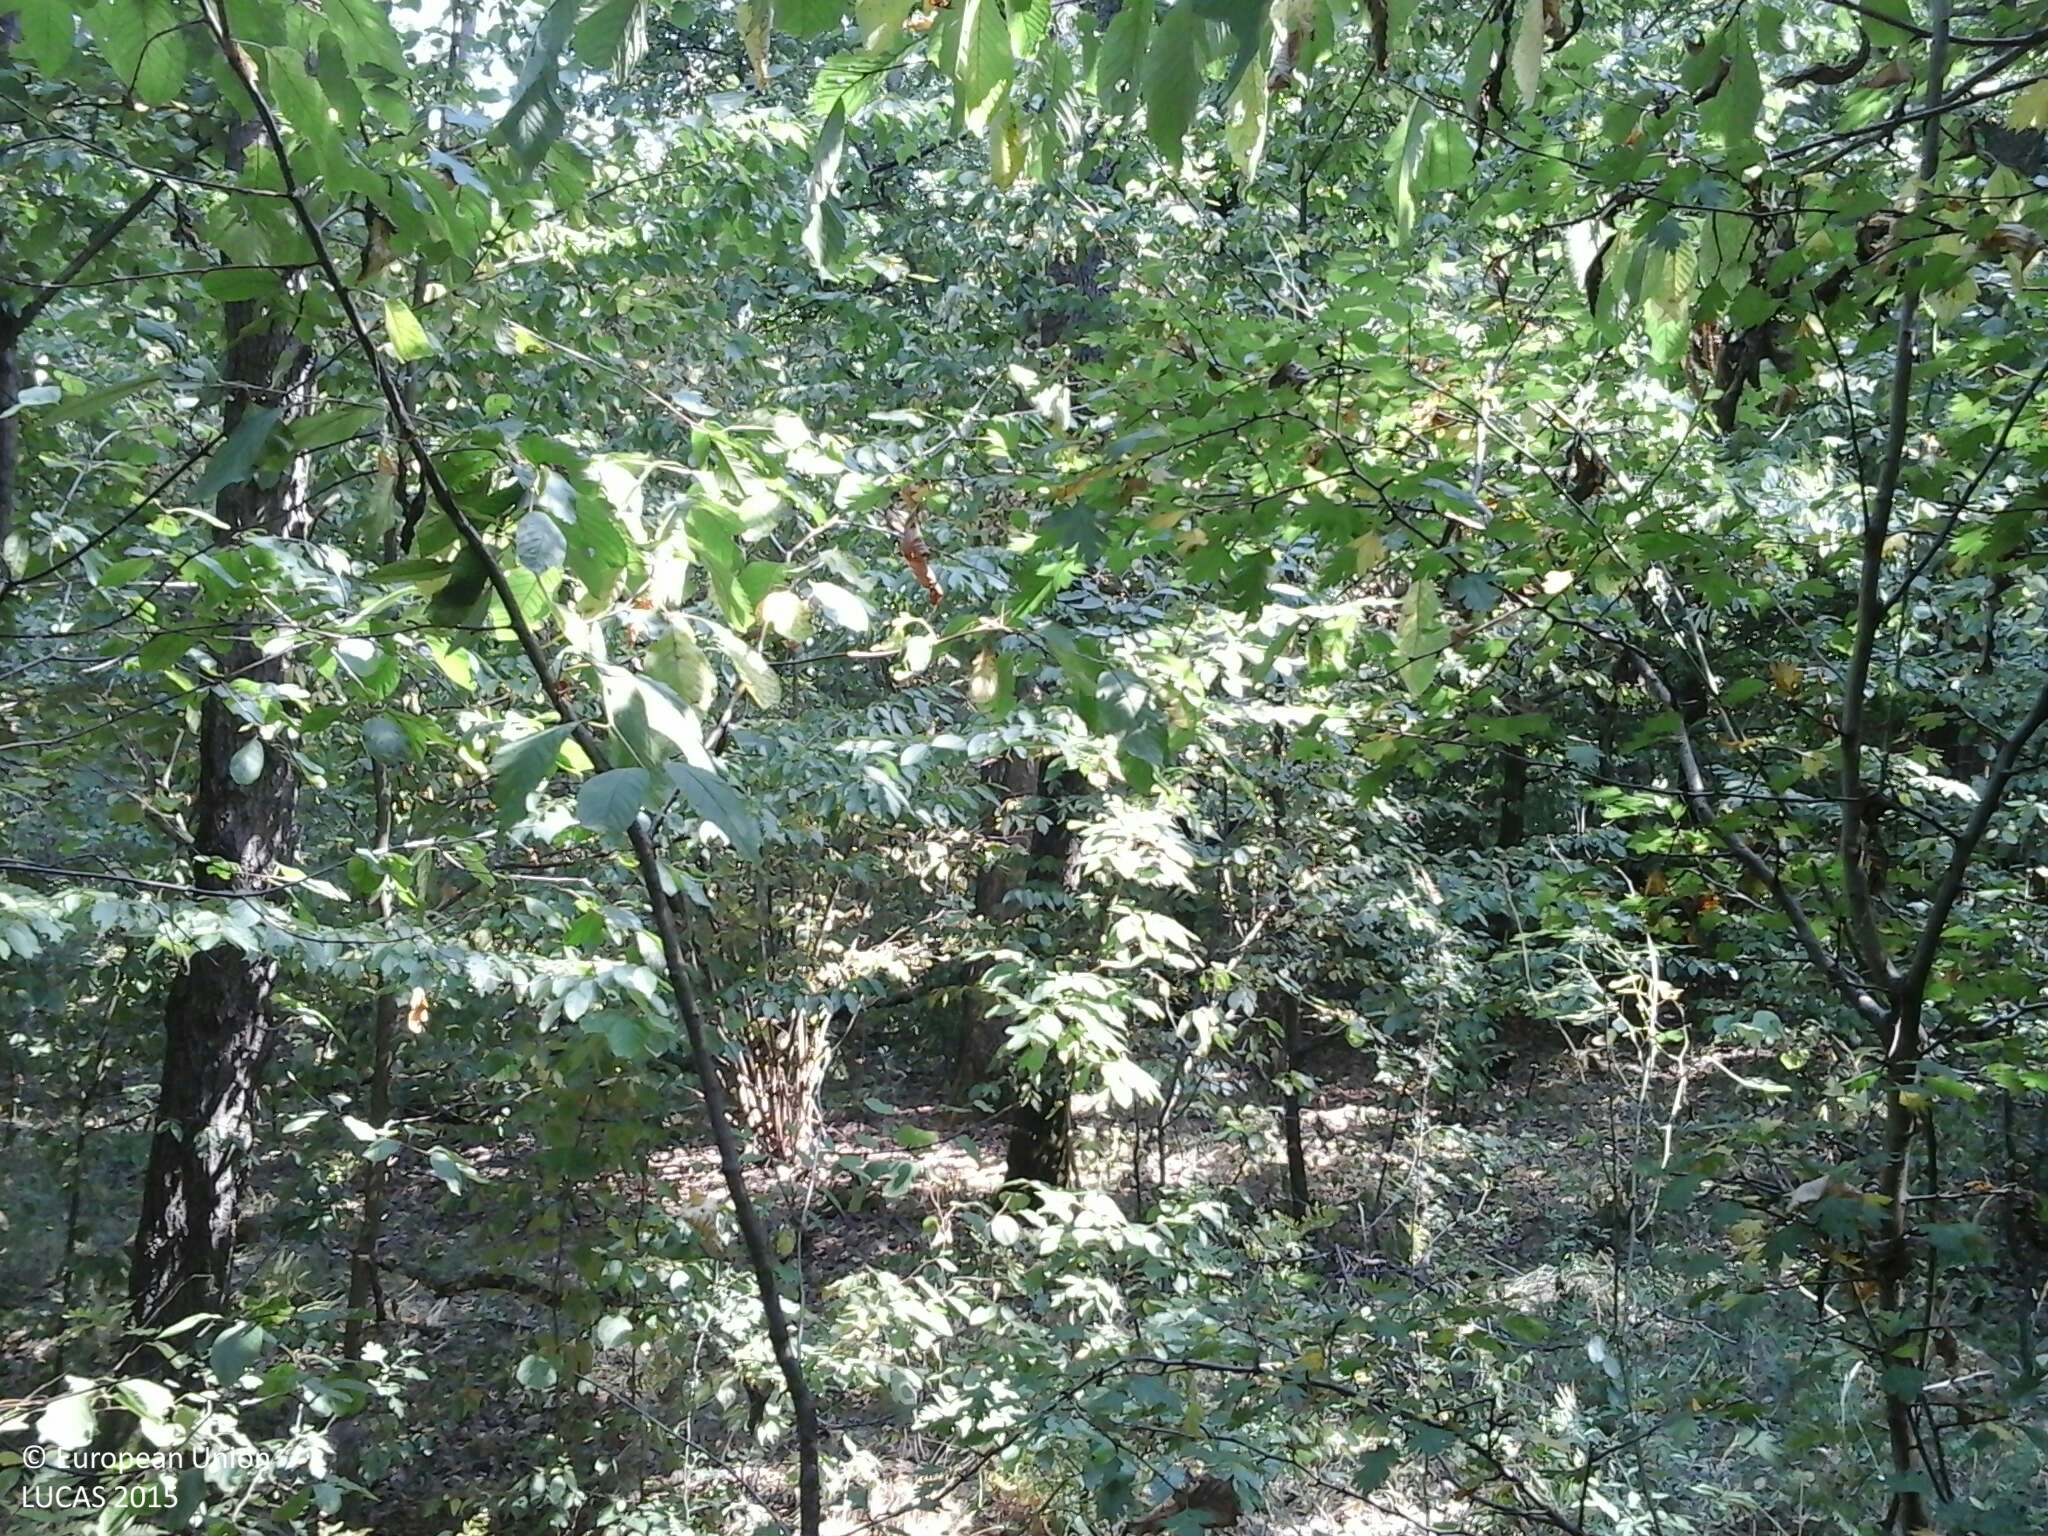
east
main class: Woodland
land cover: Broadleaved woodland
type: mesophytic deciduous forest
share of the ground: > 75 %
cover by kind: broadleaved forest trees 100 %
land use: Forestry
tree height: > 5 m
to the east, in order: Broadleaved woodland; Grassland with sparse tree/shrub cover; Broadleaved woodland
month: August
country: HU
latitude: 48.4453
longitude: 20.5121
